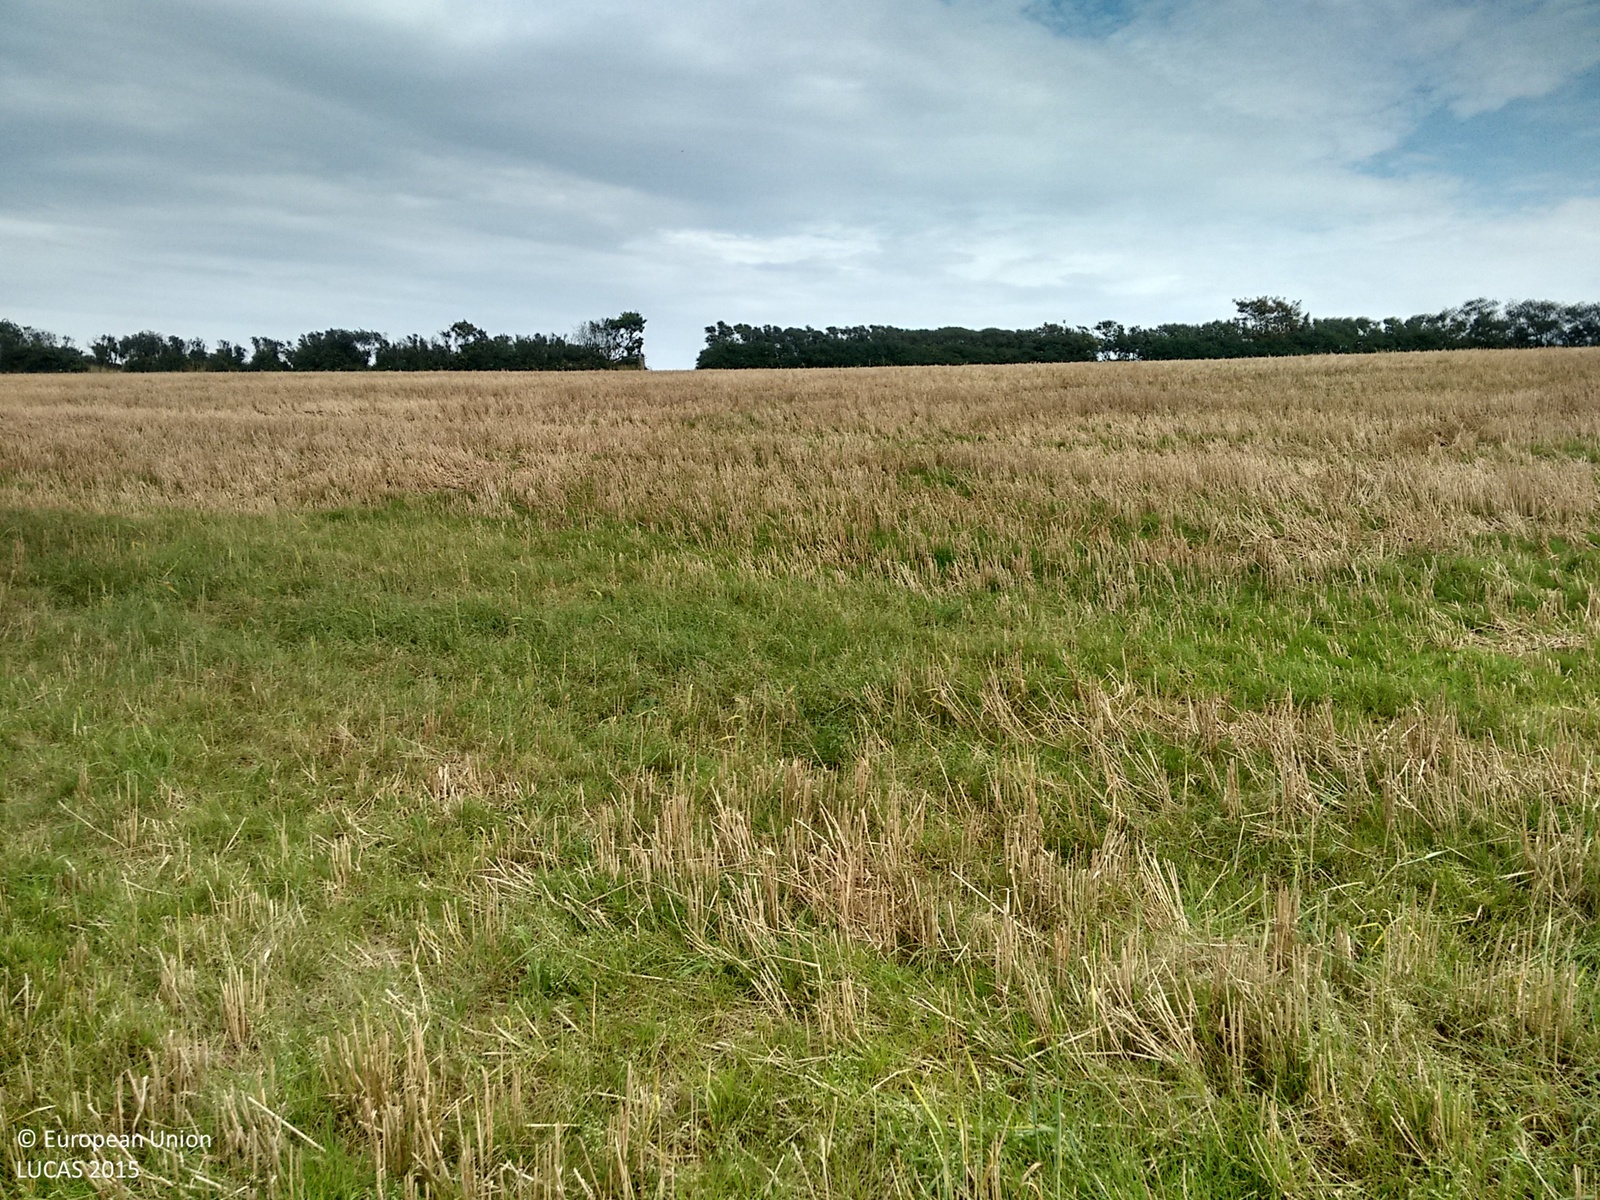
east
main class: Woodland
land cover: Broadleaved woodland
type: mesophytic deciduous forest
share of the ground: > 75 %
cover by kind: broadleaved forest trees 100 %
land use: Agriculture (excluding fallow land and kitchen gardens)
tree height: > 5 m
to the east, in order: Broadleaved woodland; Common wheat; Managed hedges; Common wheat; Fences; Managed hedges; Grassland without tree/shrub cover
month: August
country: GB
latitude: 50.0655
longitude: -5.2509
